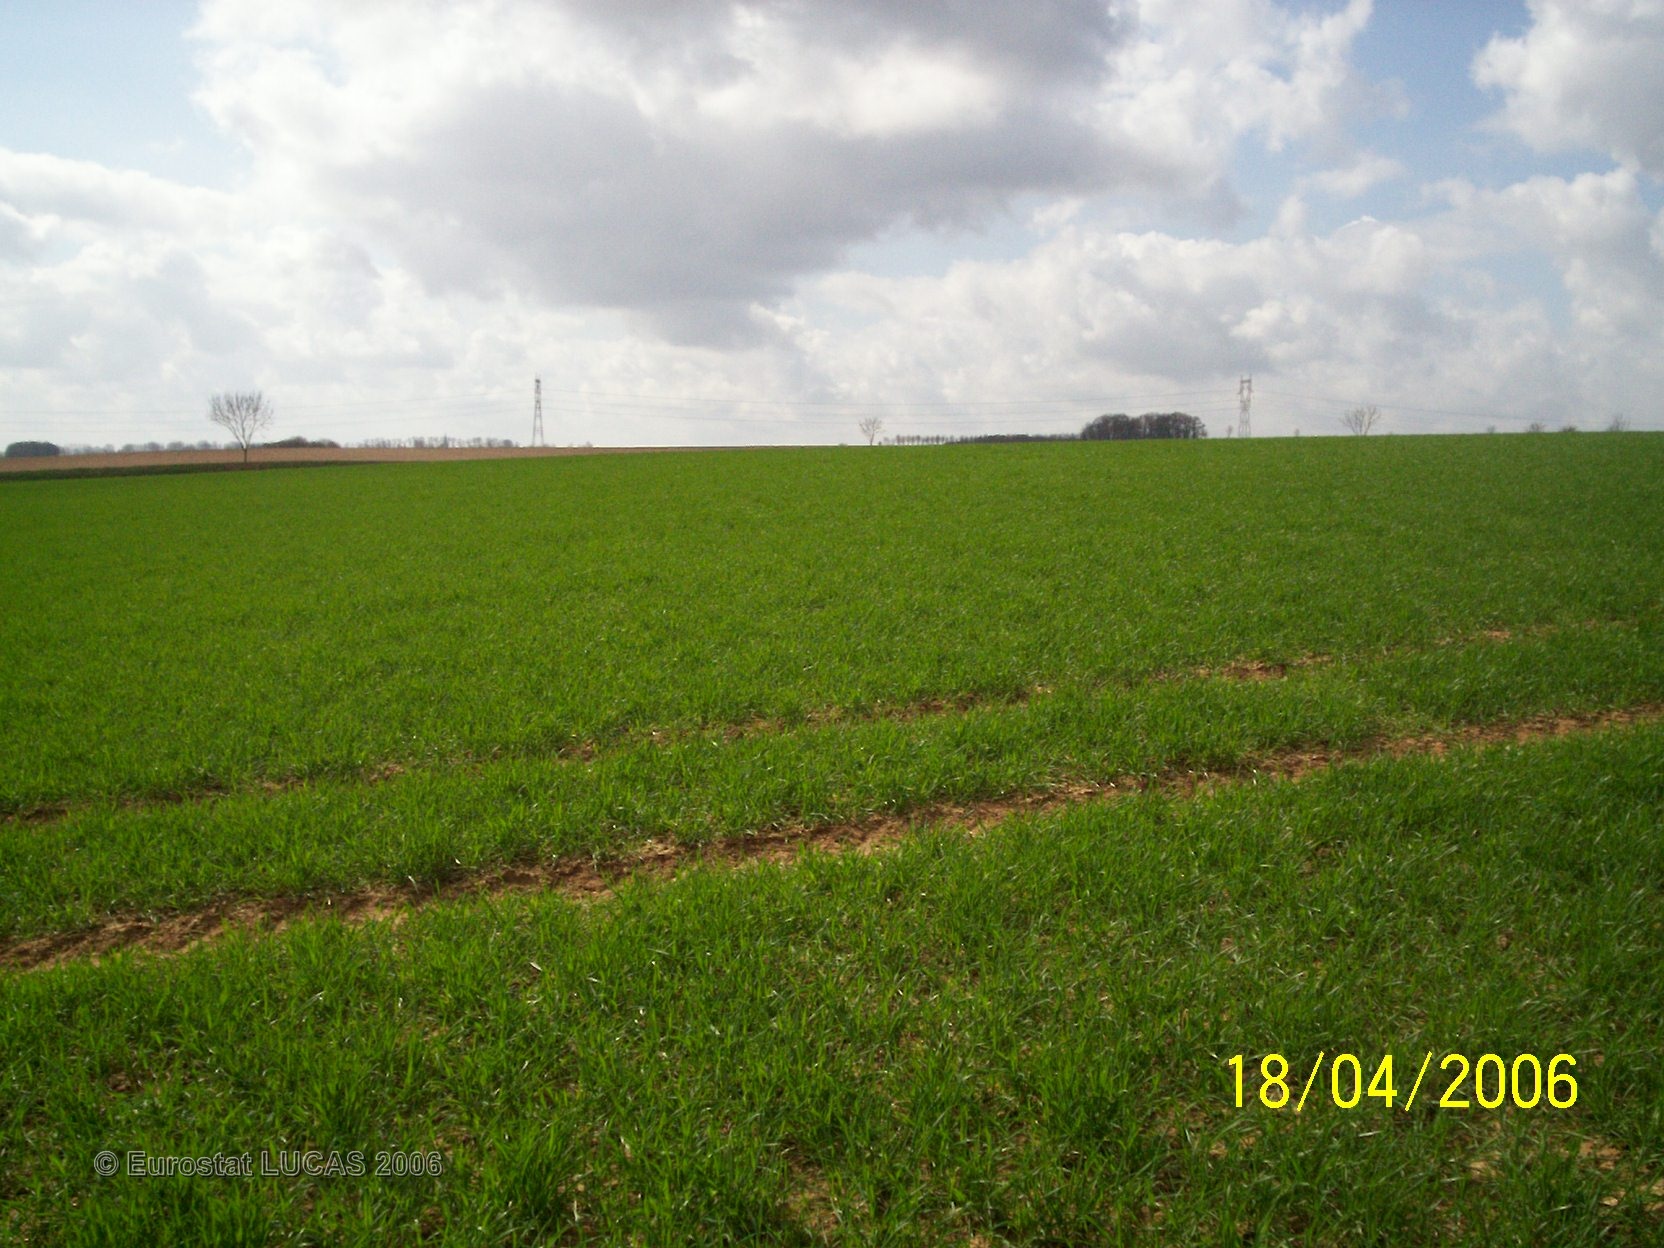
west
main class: Cropland
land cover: Common wheat
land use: Agriculture (excluding fallow land and kitchen gardens)
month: April
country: FR
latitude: 50.3362
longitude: 2.5272
